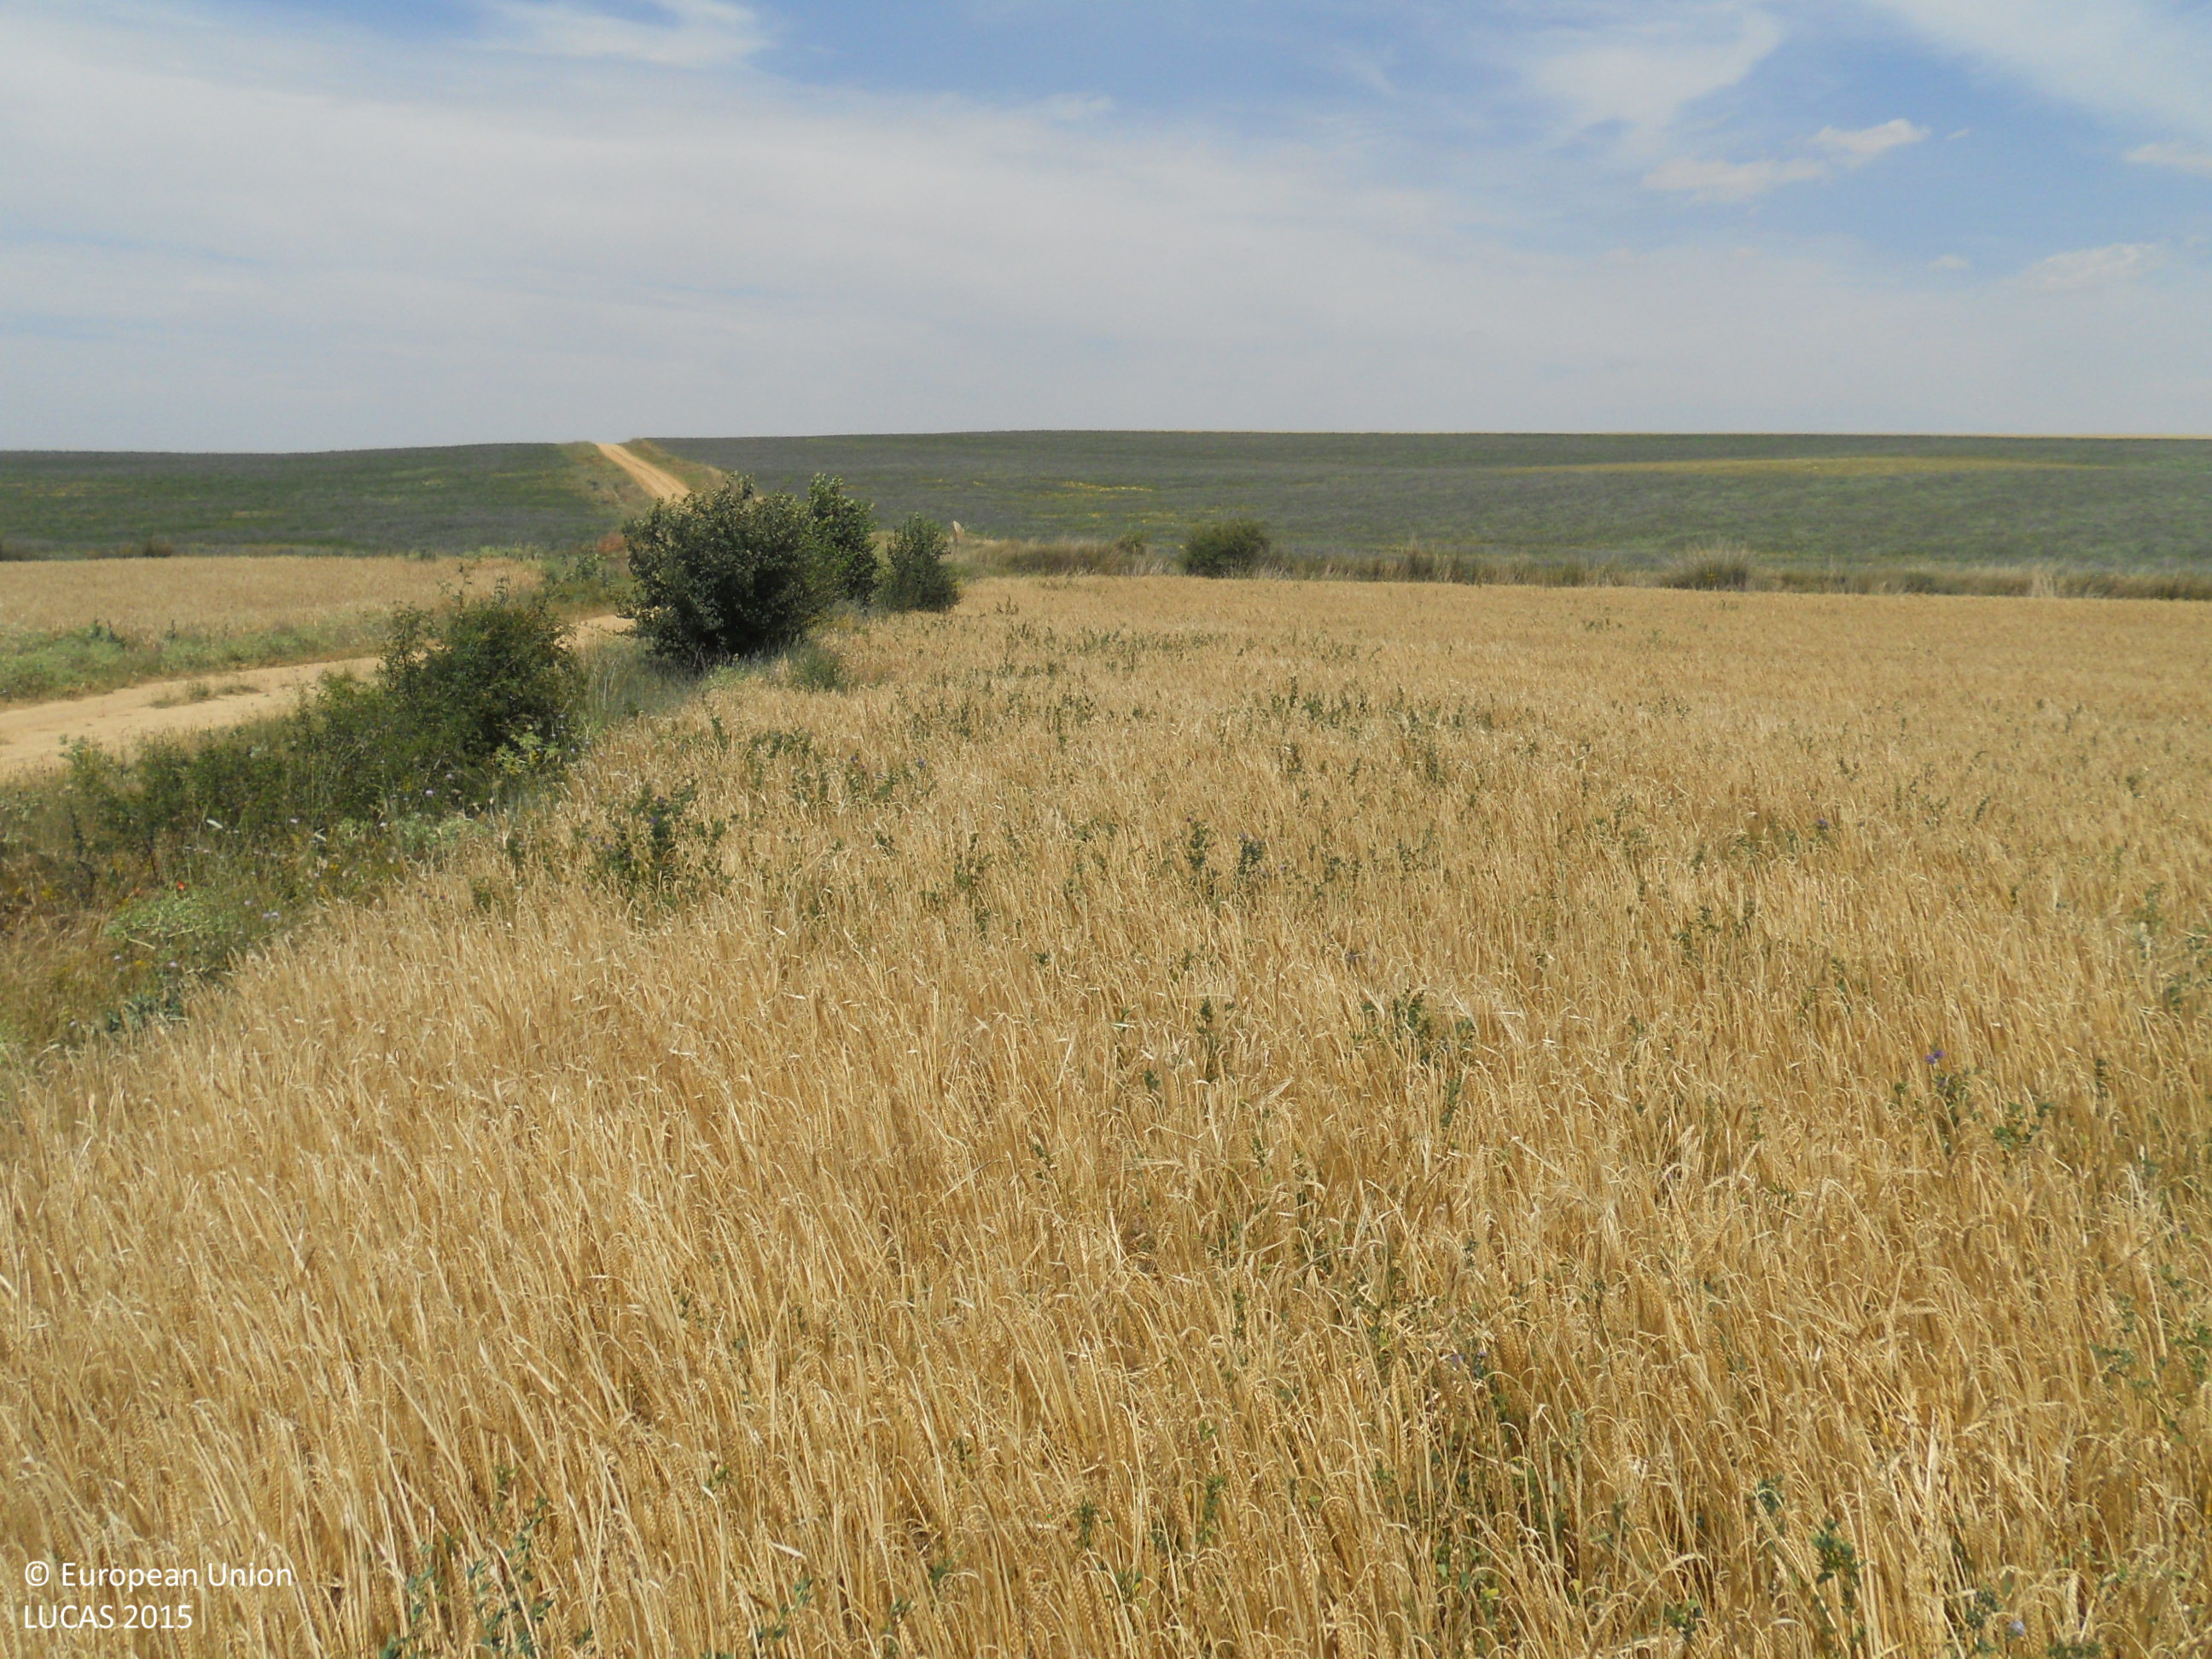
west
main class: Cropland
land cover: Barley
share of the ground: > 75 %
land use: Agriculture (excluding fallow land and kitchen gardens)
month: July
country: ES
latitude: 42.1955
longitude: -4.8399
